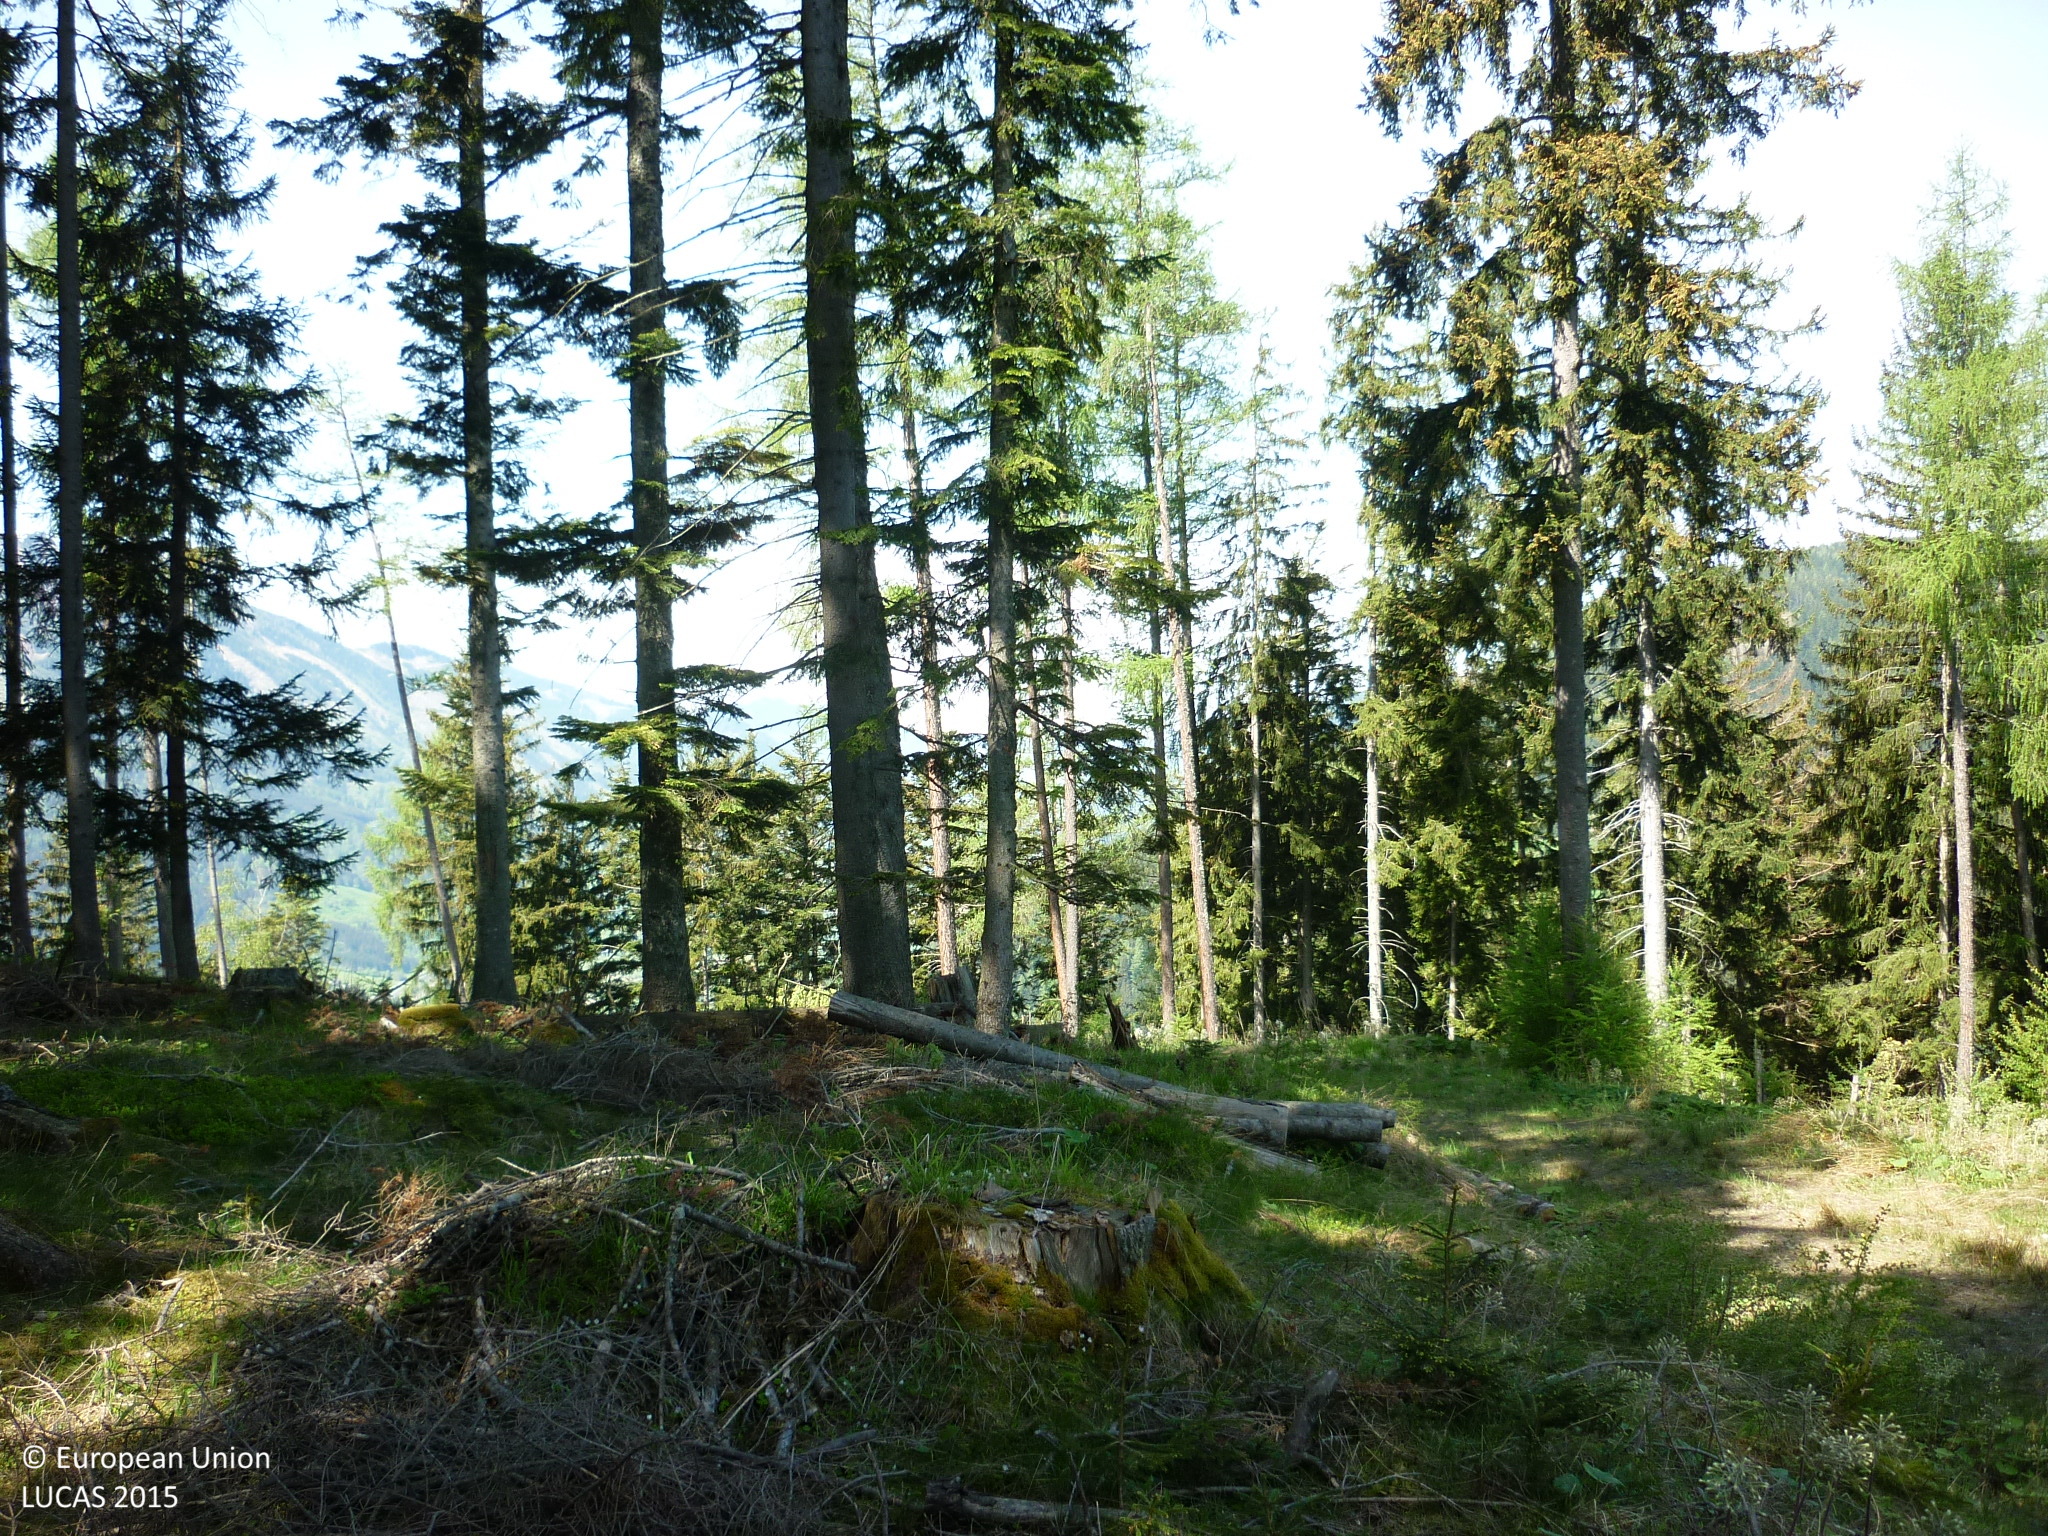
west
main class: Grassland
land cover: Grassland with sparse tree/shrub cover
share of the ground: > 75 %
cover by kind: herbaceous plants 90 %, coniferous forest trees 5 %, lichens and mosses 5 %
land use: Forestry
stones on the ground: < 10 %
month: May
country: AT
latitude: 47.5210
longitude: 14.4481
